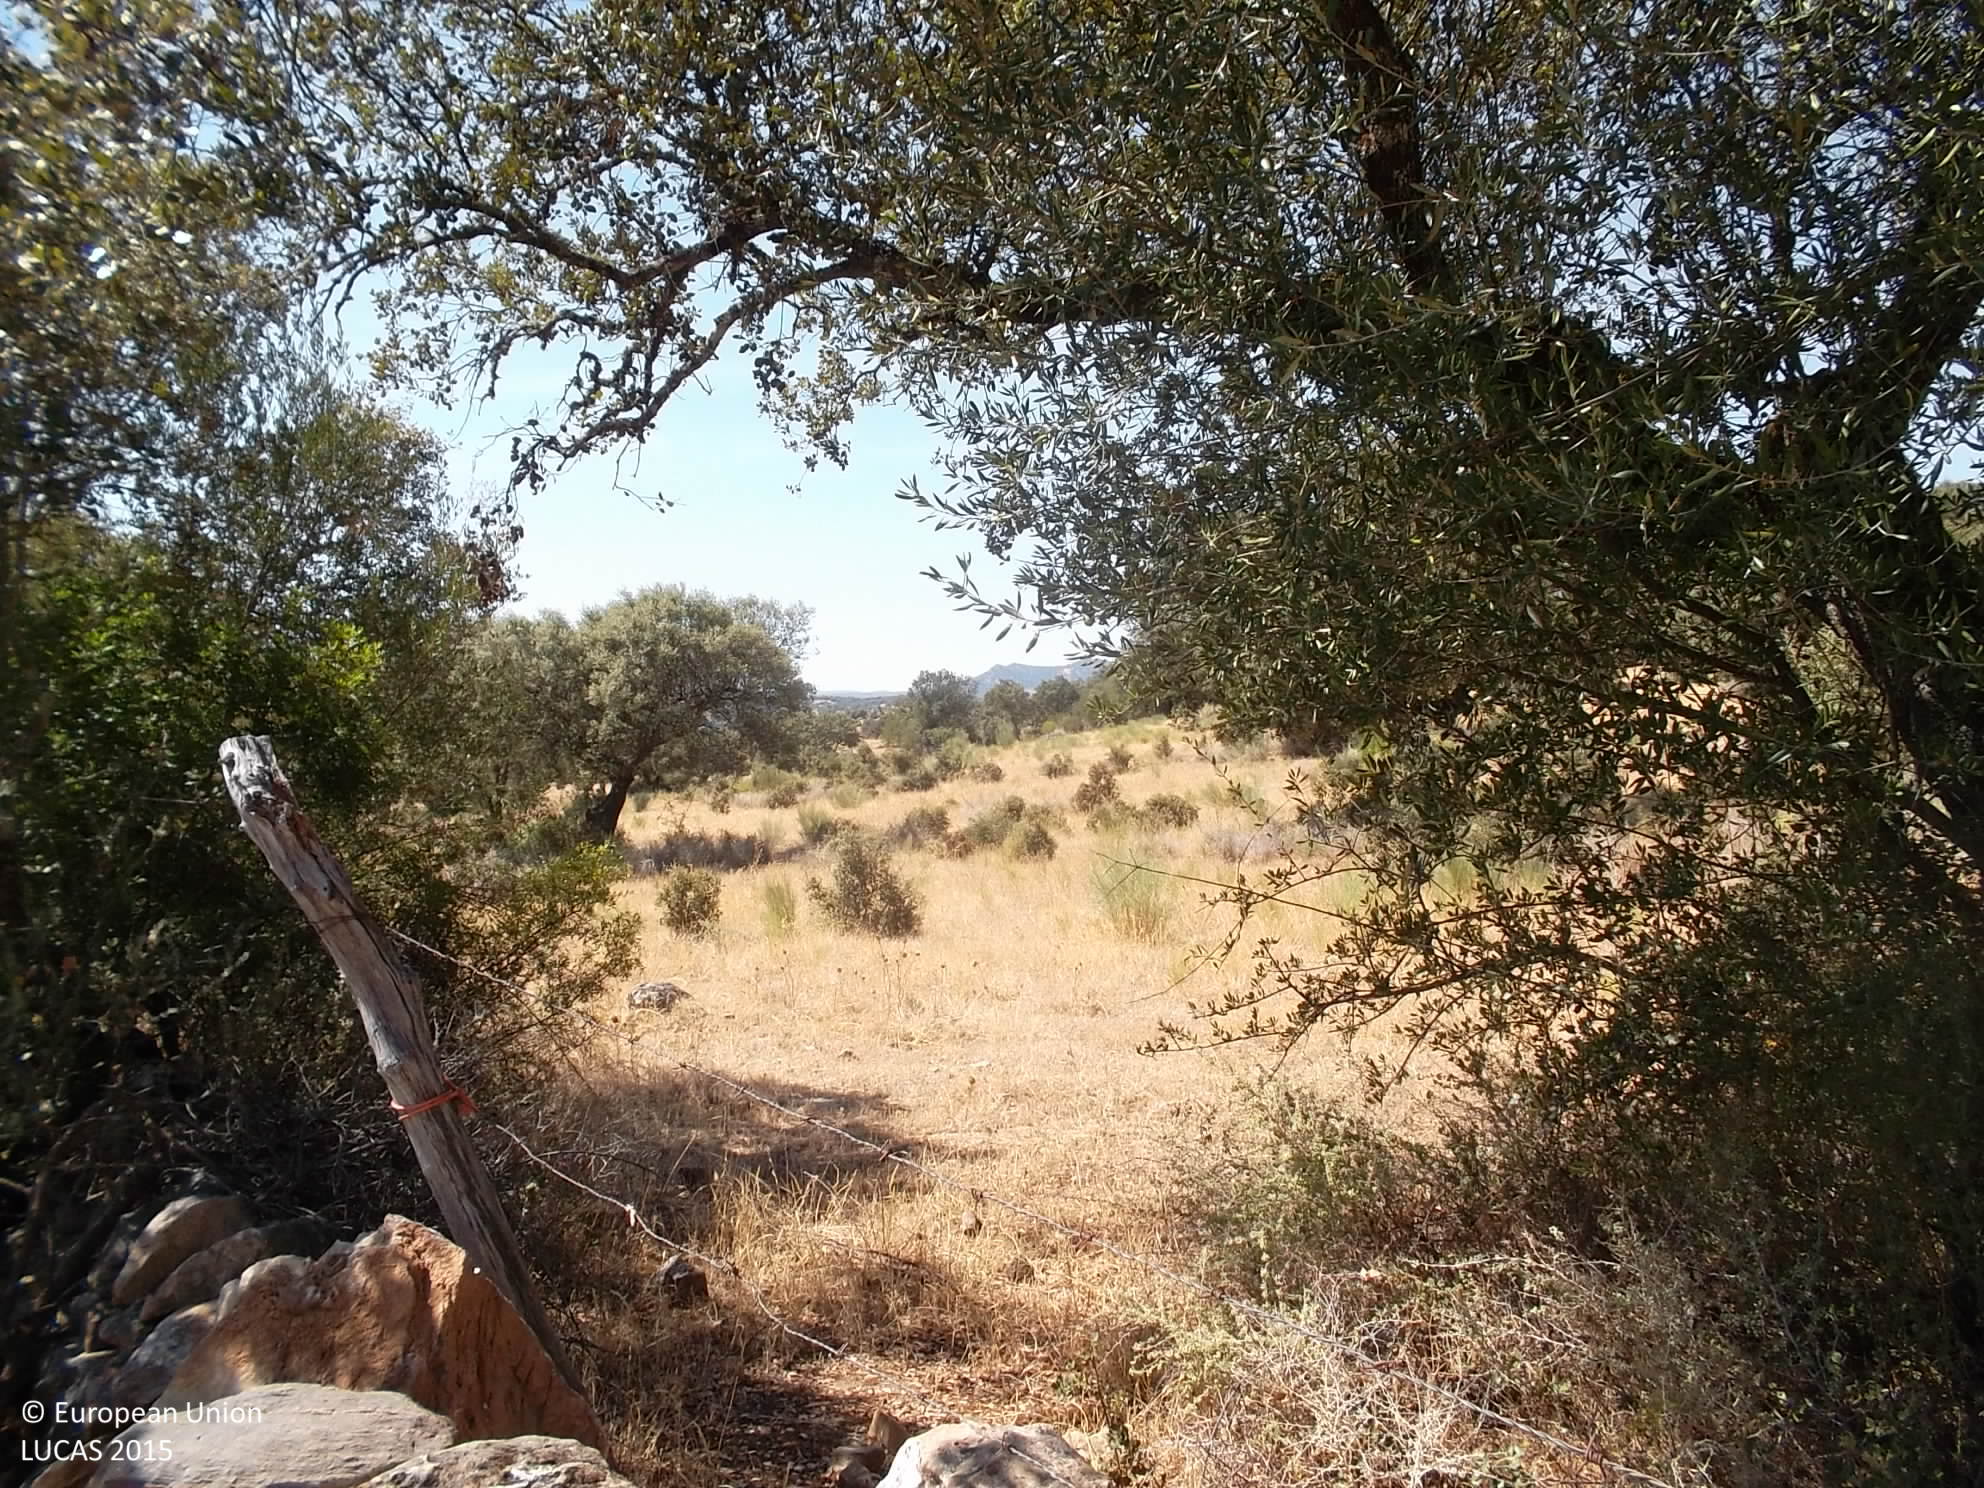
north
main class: Woodland
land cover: Broadleaved woodland
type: broadleaved evergreen forest
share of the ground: 25 - 50 %
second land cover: Grassland without tree/shrub cover
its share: > 75 %
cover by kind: herbaceous plants 55 %, broadleaved forest trees 35 %, shrubs 10 %
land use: Forestry
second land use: Agriculture (excluding fallow land and kitchen gardens)
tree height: < 5 m
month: August
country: ES
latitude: 38.3330
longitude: -6.5593
